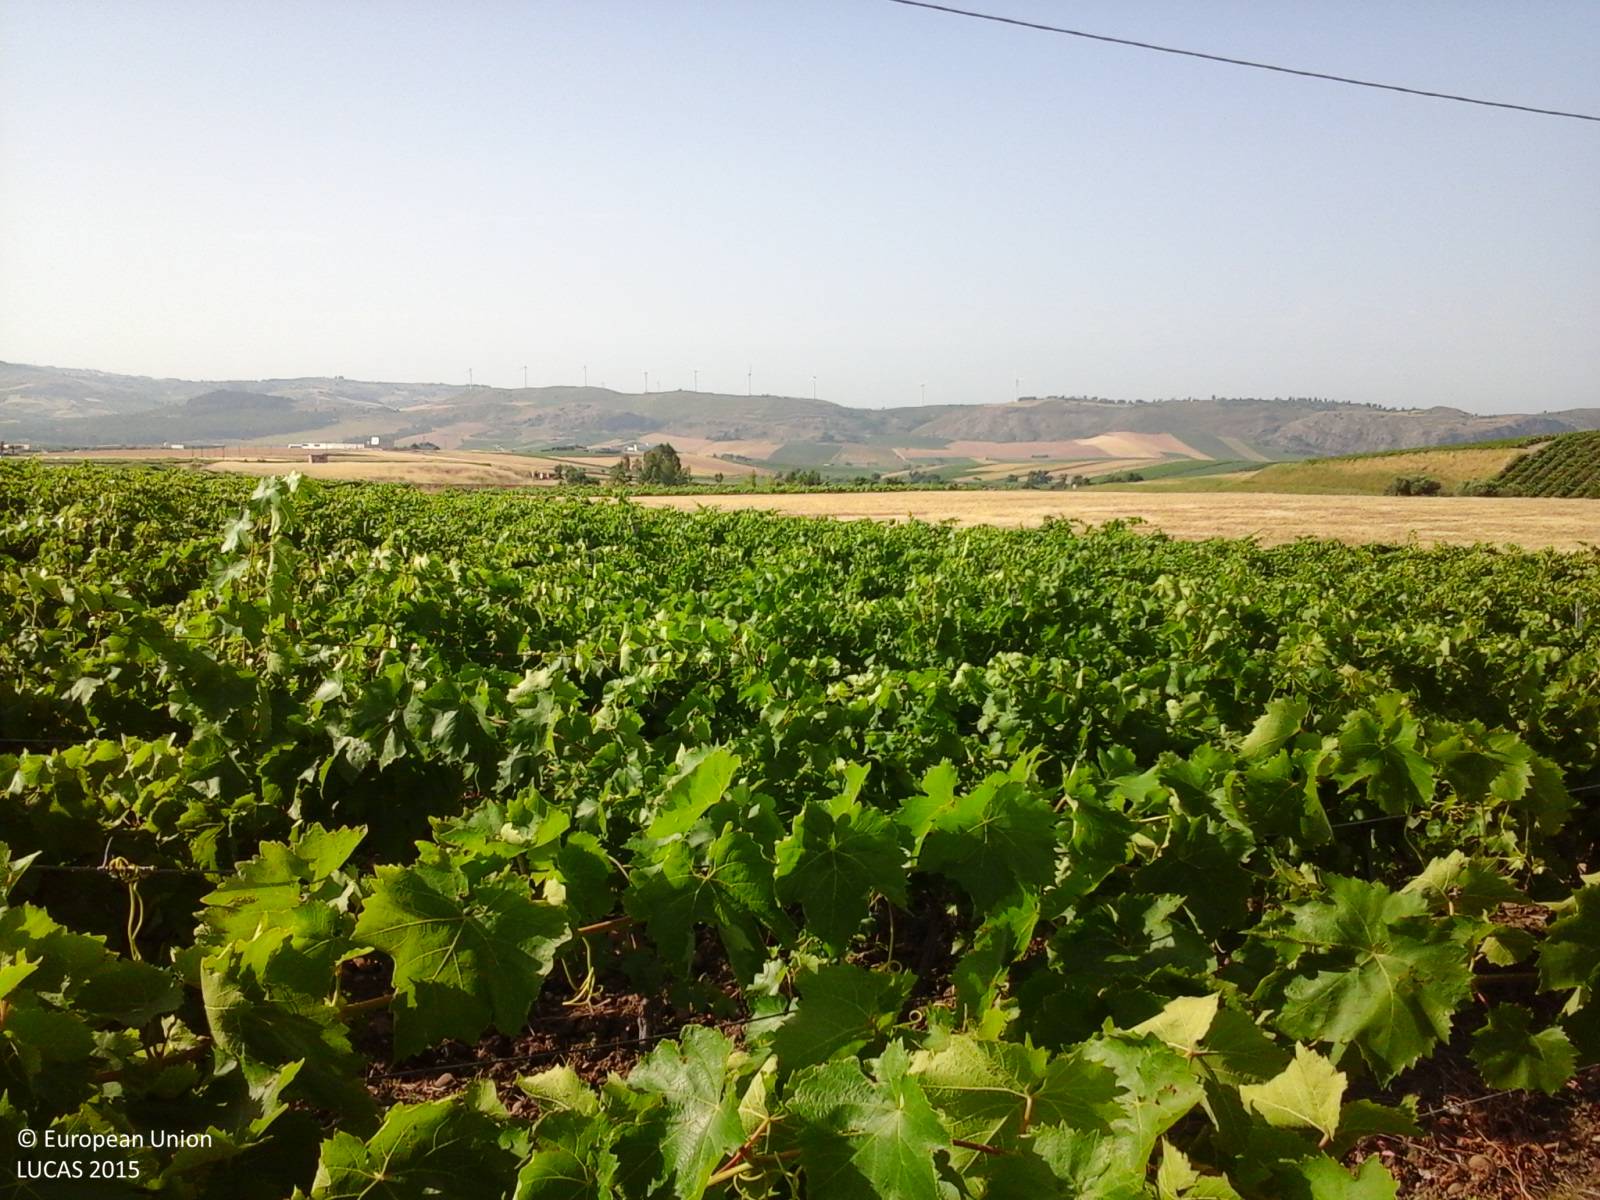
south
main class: Cropland
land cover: Vineyards
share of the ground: 50 - 75 %
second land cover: Other bare soil
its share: > 75 %
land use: Agriculture (excluding fallow land and kitchen gardens)
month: June
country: IT
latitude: 37.8144
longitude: 12.8302
